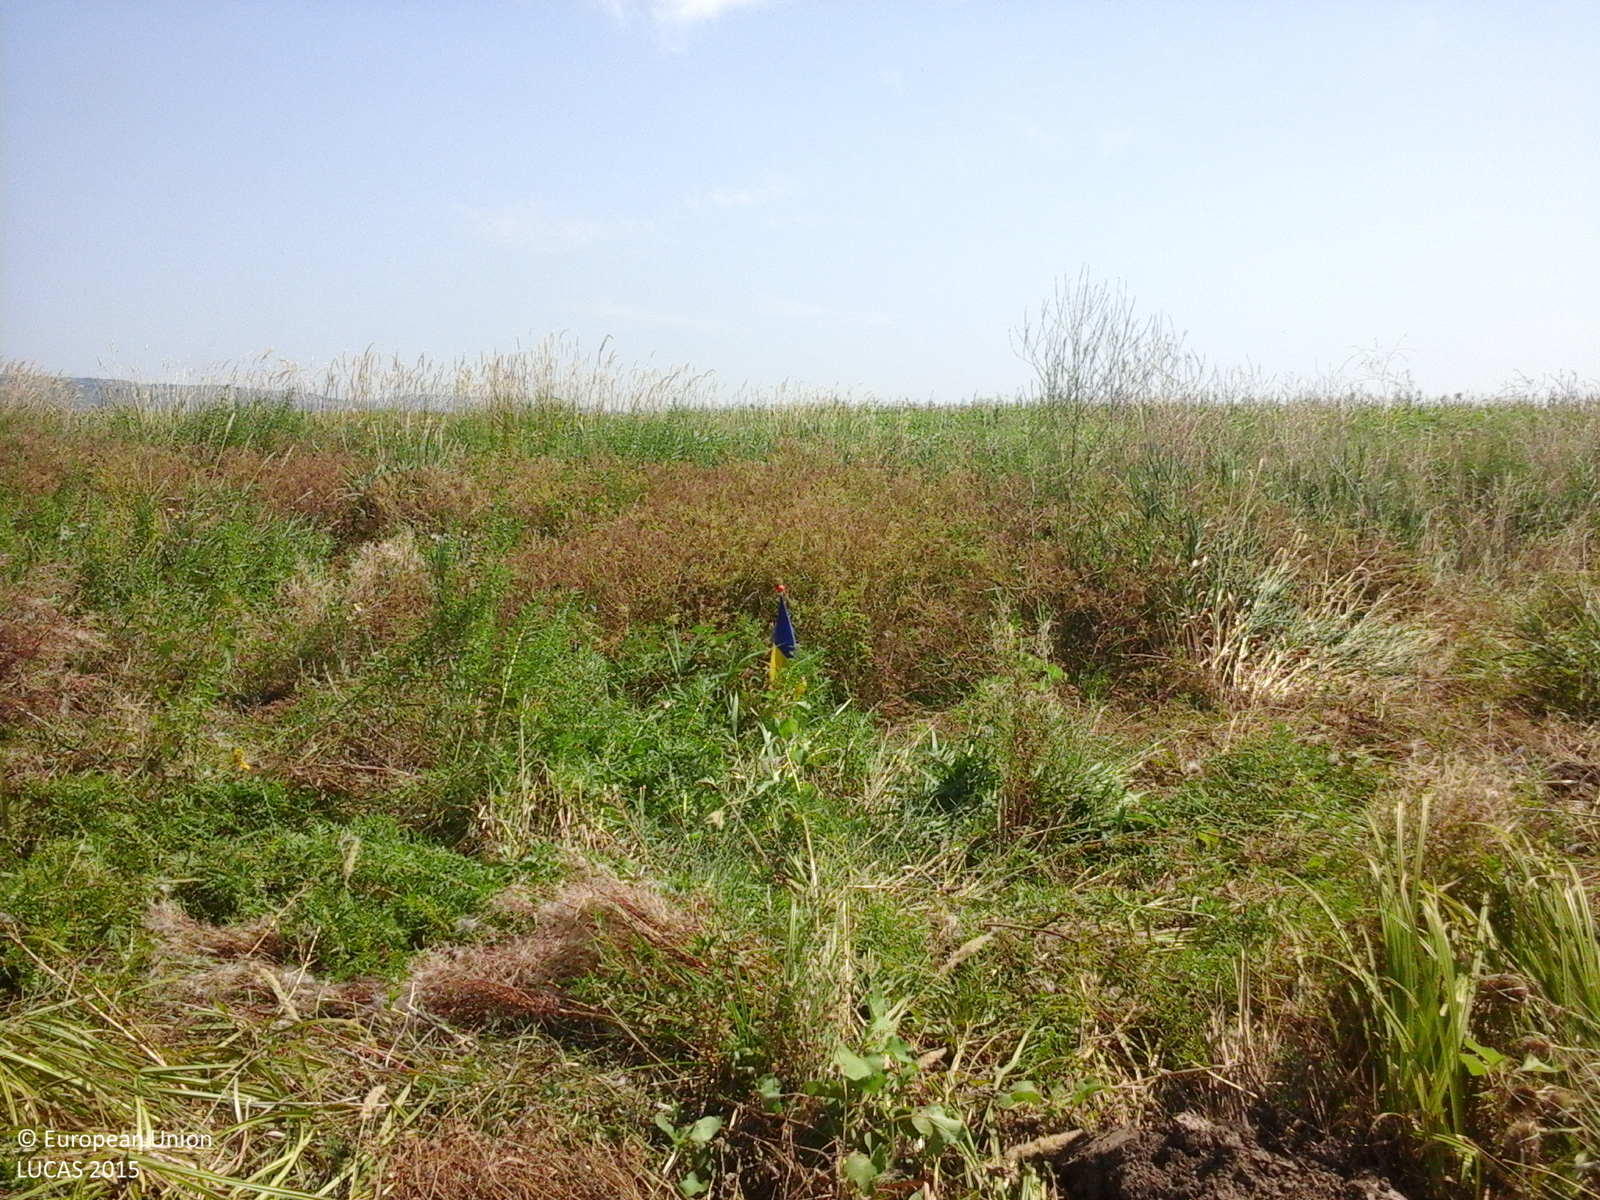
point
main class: Grassland
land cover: Spontaneously vegetated surfaces
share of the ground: > 75 %
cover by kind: herbaceous plants 100 %
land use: Fallow land
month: August
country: RO
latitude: 46.2269
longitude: 27.1210
